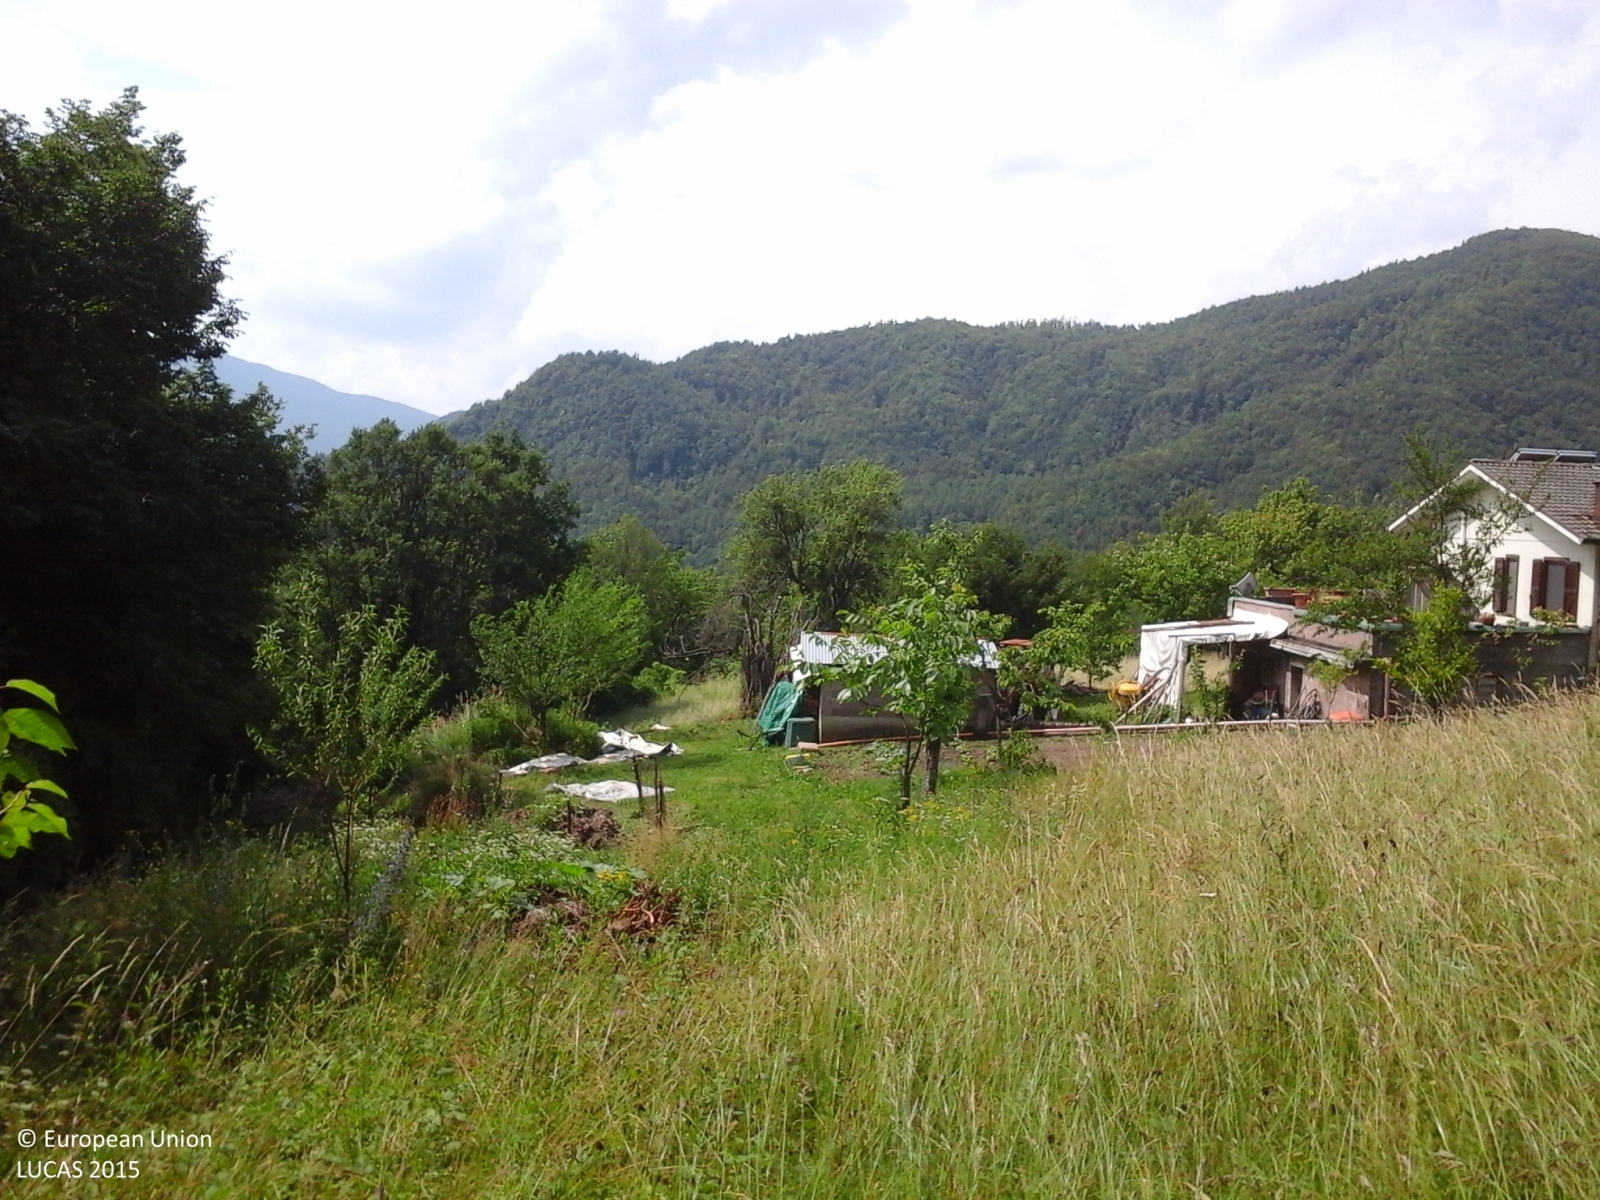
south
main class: Woodland
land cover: Broadleaved woodland
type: thermophilous deciduous forest
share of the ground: > 75 %
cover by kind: broadleaved forest trees 95 %, herbaceous plants 5 %
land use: Forestry
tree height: > 5 m
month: June
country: IT
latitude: 44.6204
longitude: 9.6353
